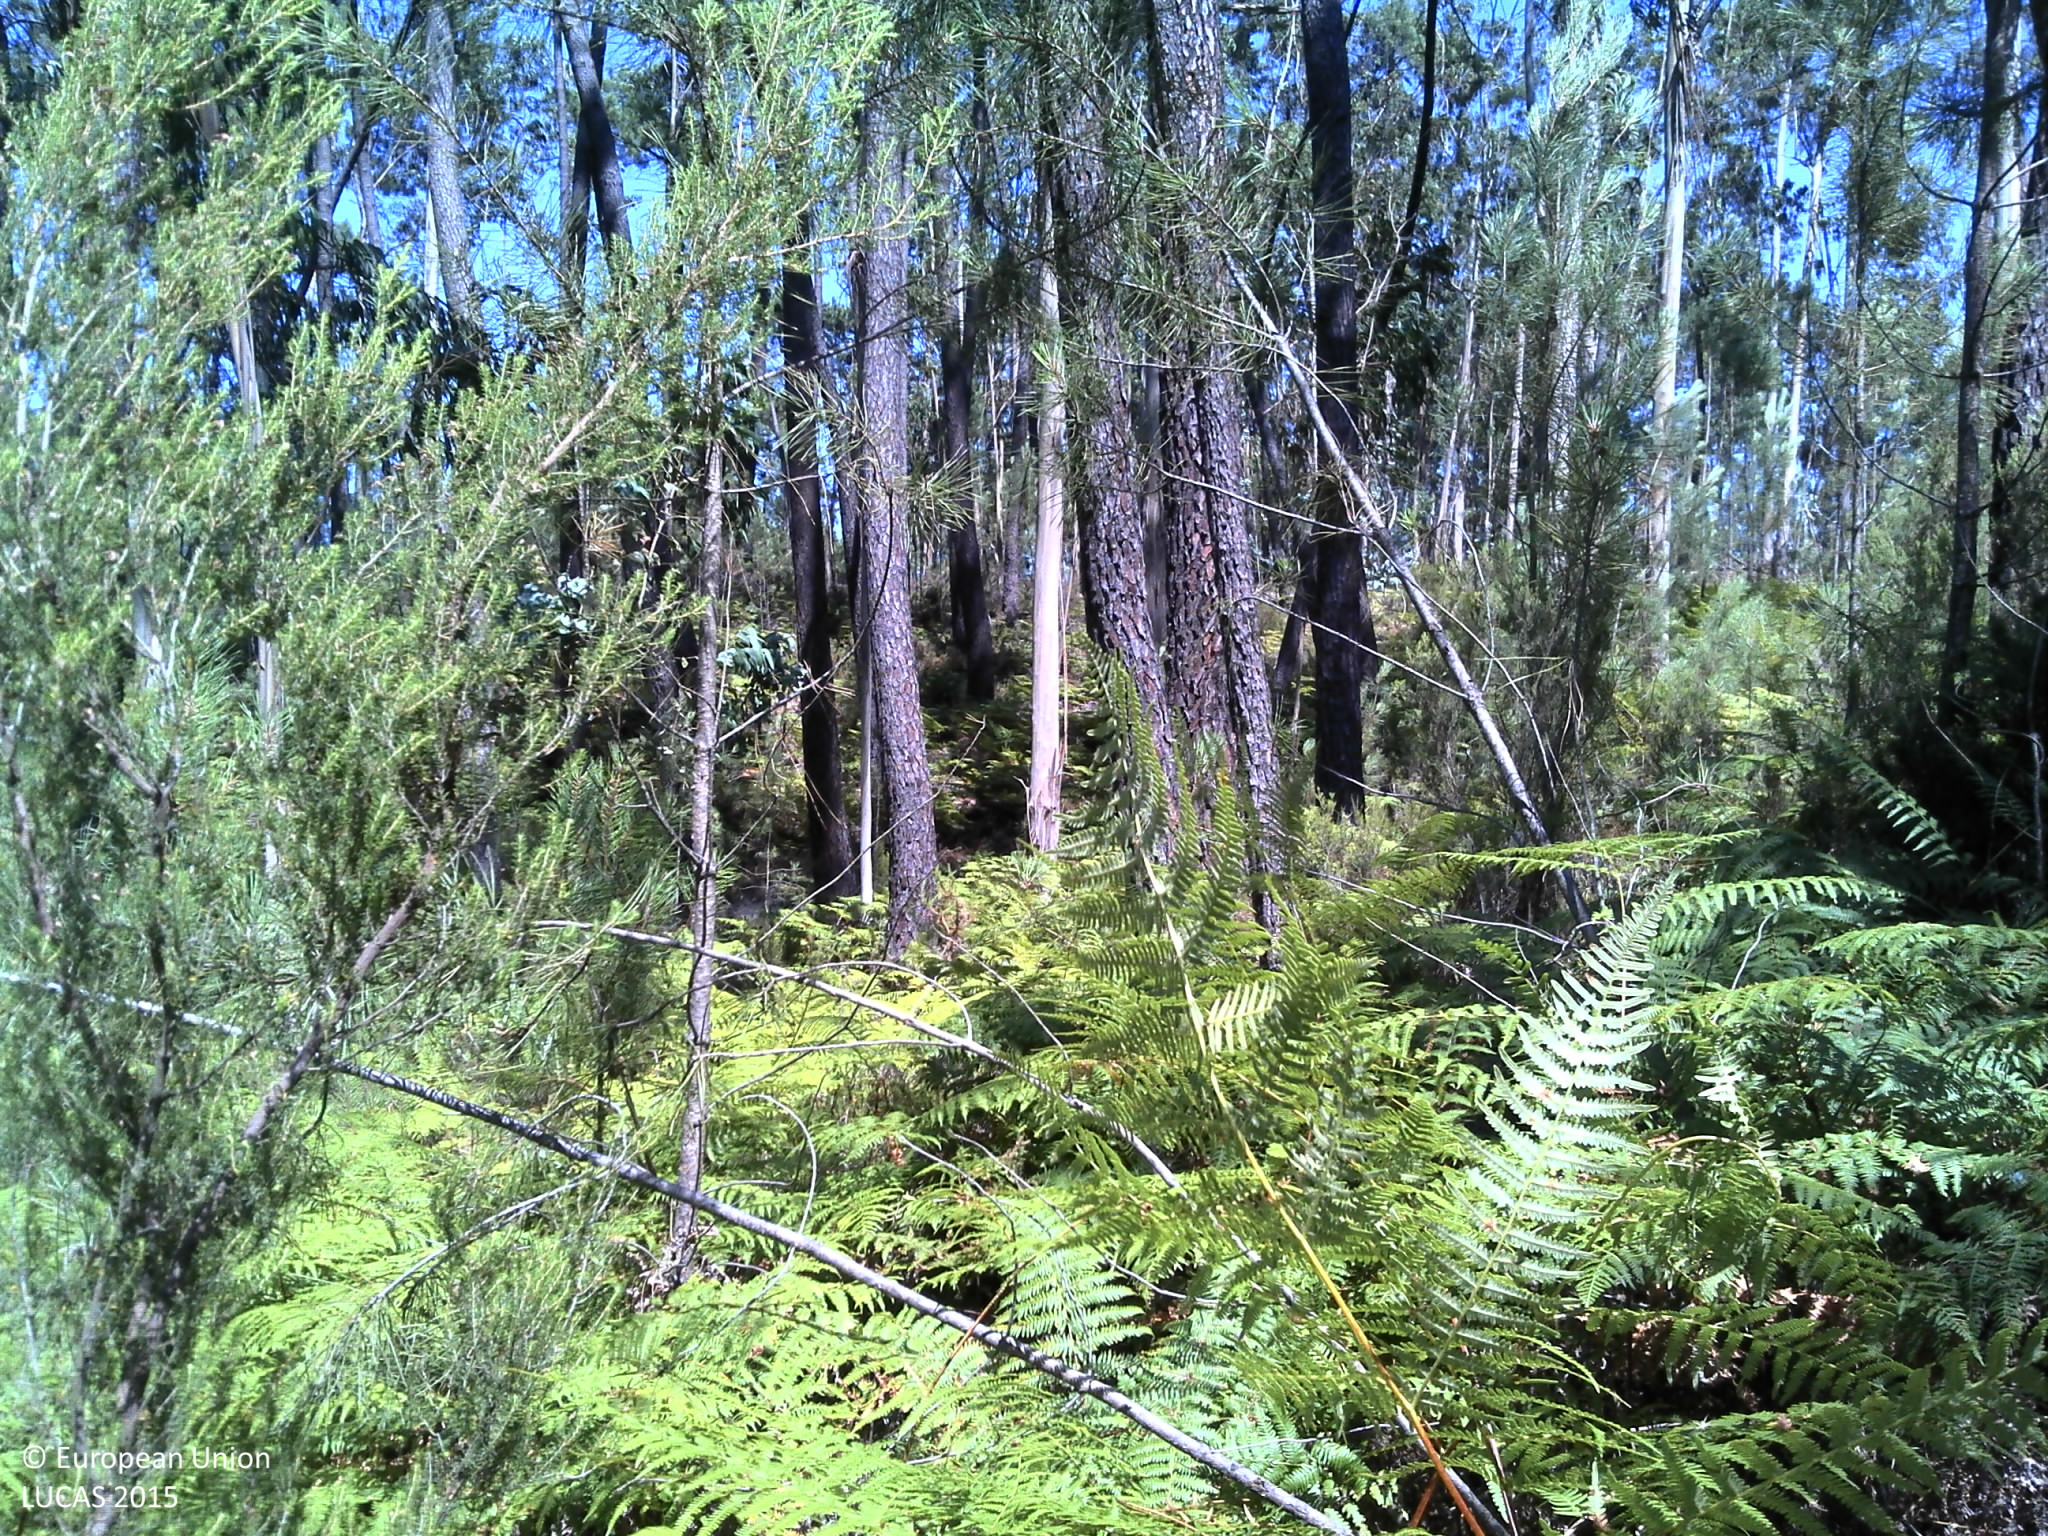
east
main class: Woodland
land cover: Pine dominated coniferous woodland
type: coniferous forest of the mediterranean region
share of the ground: 50 - 75 %
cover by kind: coniferous forest trees 50 %, shrubs 20 %, herbaceous plants 20 %, unconsolidated bare surface 10 %
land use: Forestry
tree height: > 5 m
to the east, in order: Pine dominated coniferous woodland; Tracks; Pine dominated coniferous woodland; Broadleaved woodland; Pine dominated coniferous woodland; Pine dominated mixed woodland
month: July
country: PT
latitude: 39.7258
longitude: -8.5226
